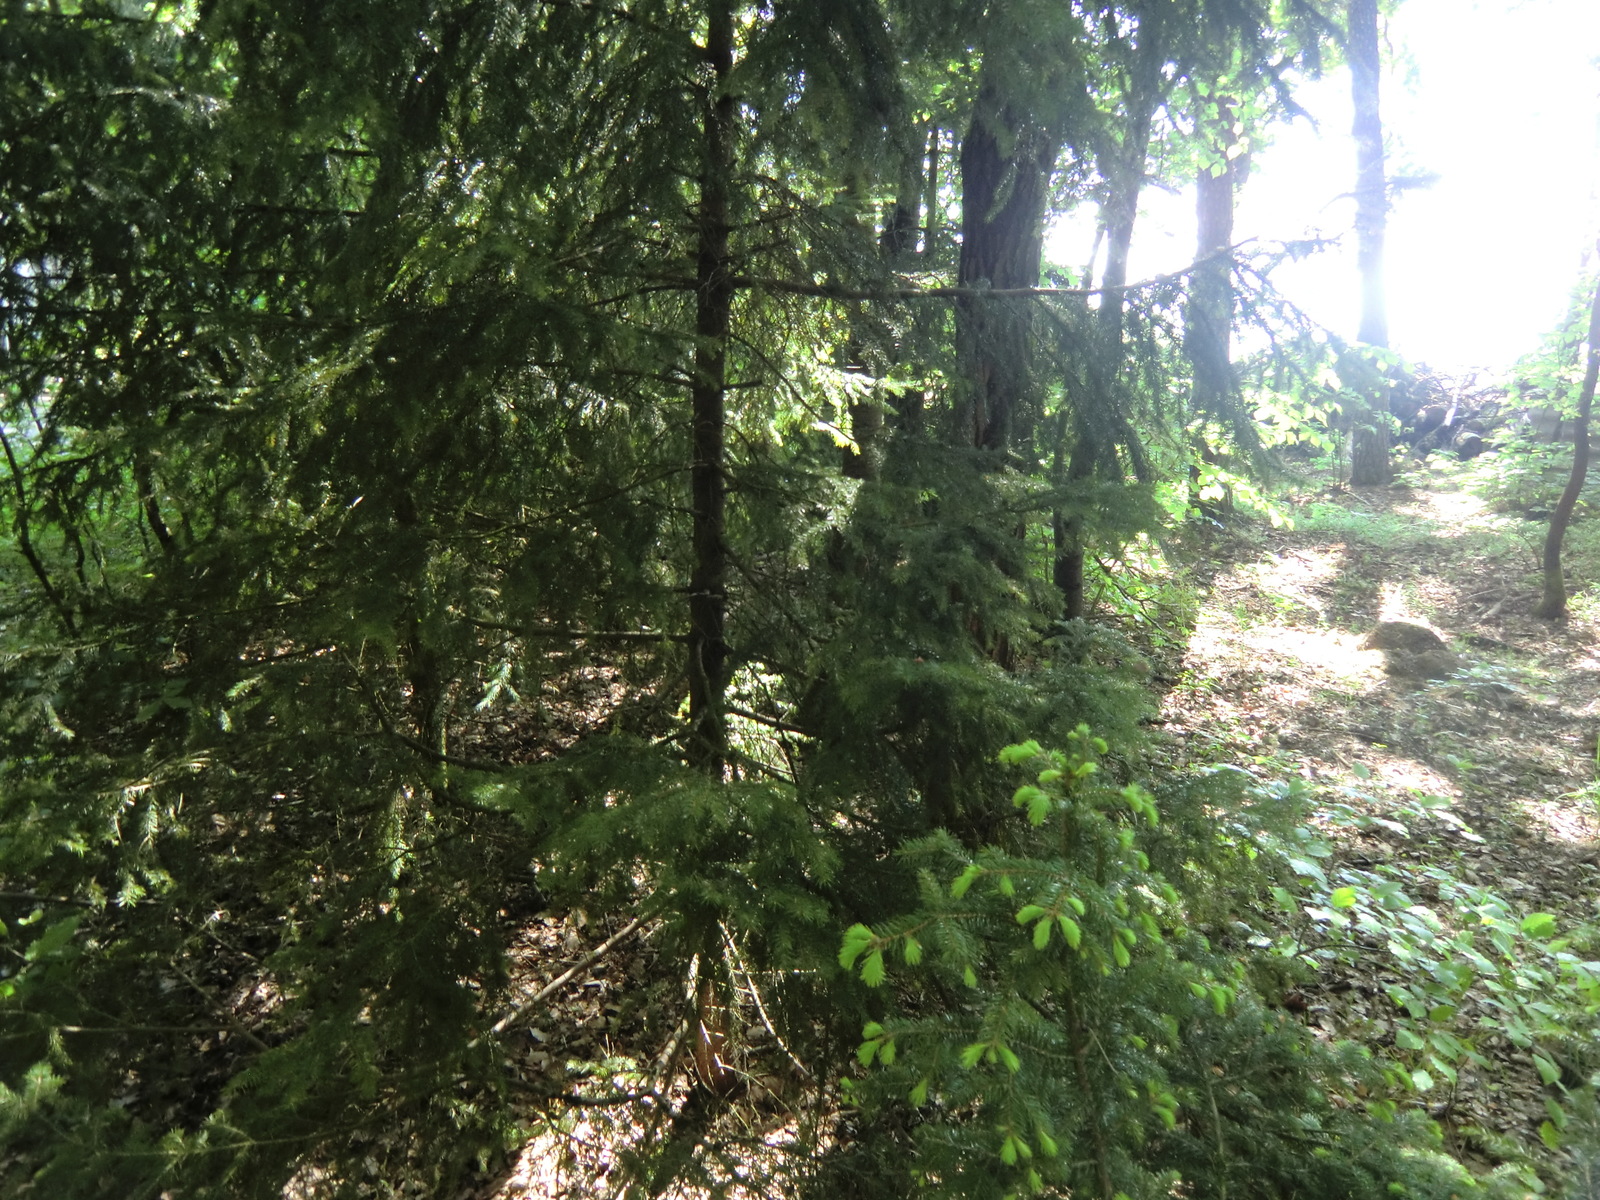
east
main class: Woodland
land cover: Pine dominated mixed woodland
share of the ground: > 75 %
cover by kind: coniferous forest trees 40 %, broadleaved forest trees 40 %, shrubs 5 %, herbaceous plants 5 %, lichens and mosses 5 %, consolidated bare surface 5 %
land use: Forestry
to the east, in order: Pine dominated mixed woodland; Tracks; Pine dominated mixed woodland; Paved roads, cycling and walking lanes; Spruce dominated coniferous woodland; Tracks; Spruce dominated mixed woodland; Tracks; Shrubland with sparse tree cover; Spruce dominated coniferous woodland; Tracks; Spruce dominated mixed woodland
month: May
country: AT
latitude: 48.3145
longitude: 14.4368
